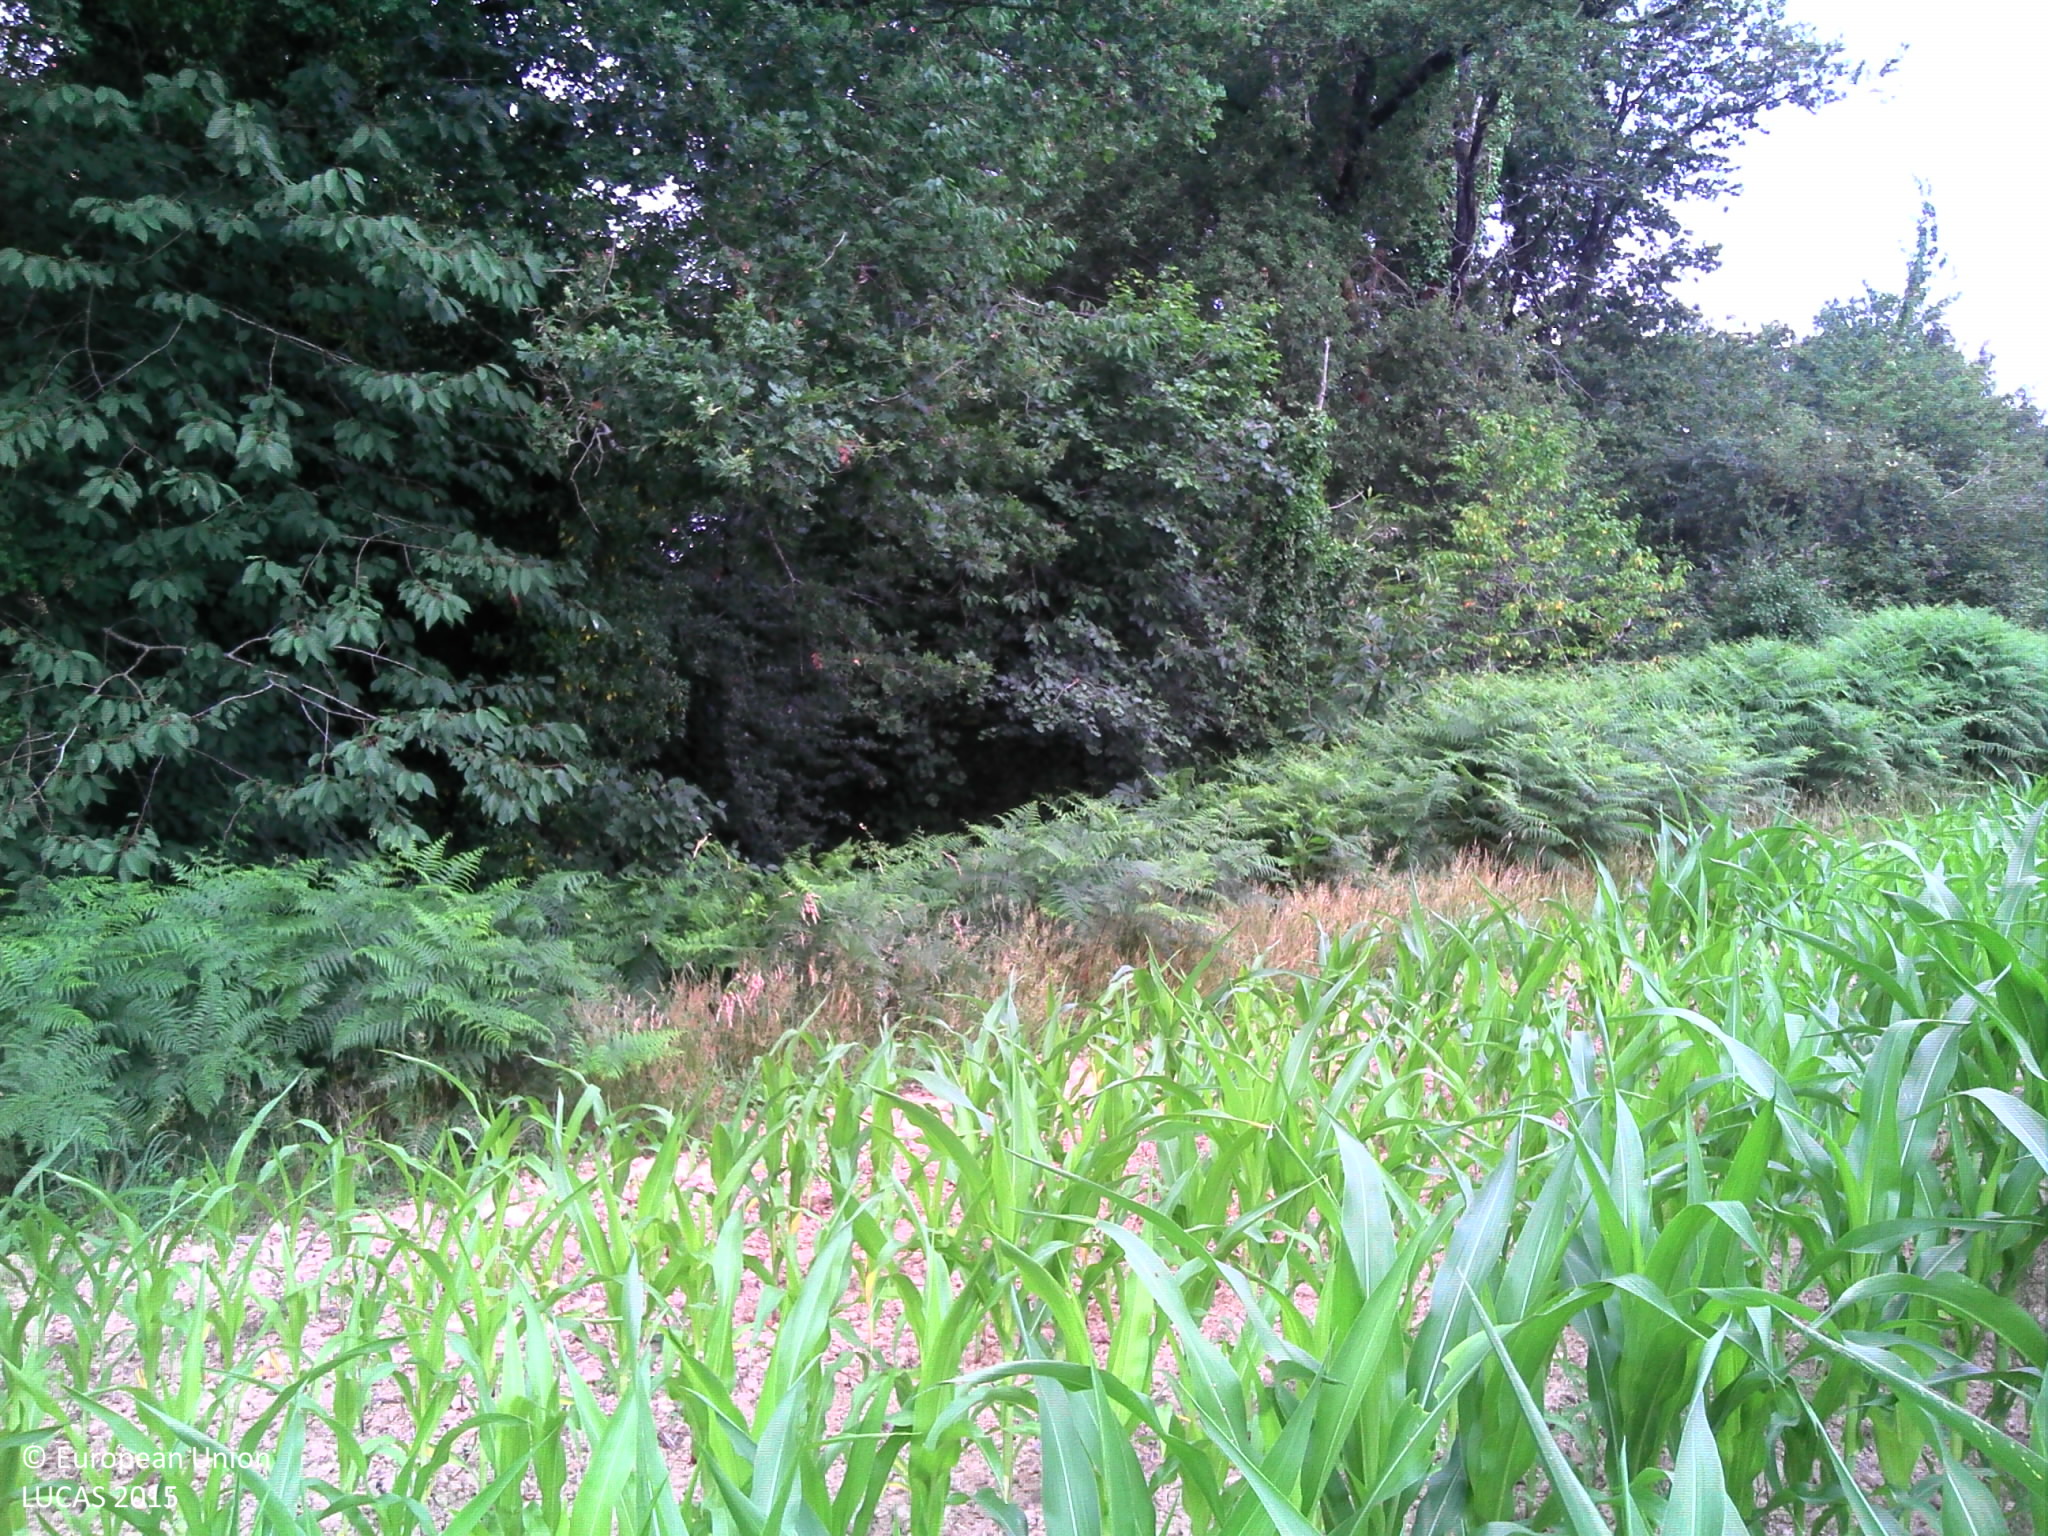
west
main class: Cropland
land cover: Maize
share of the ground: 50 - 75 %
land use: Agriculture (excluding fallow land and kitchen gardens)
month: July
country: FR
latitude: 43.5751
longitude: -0.7228
